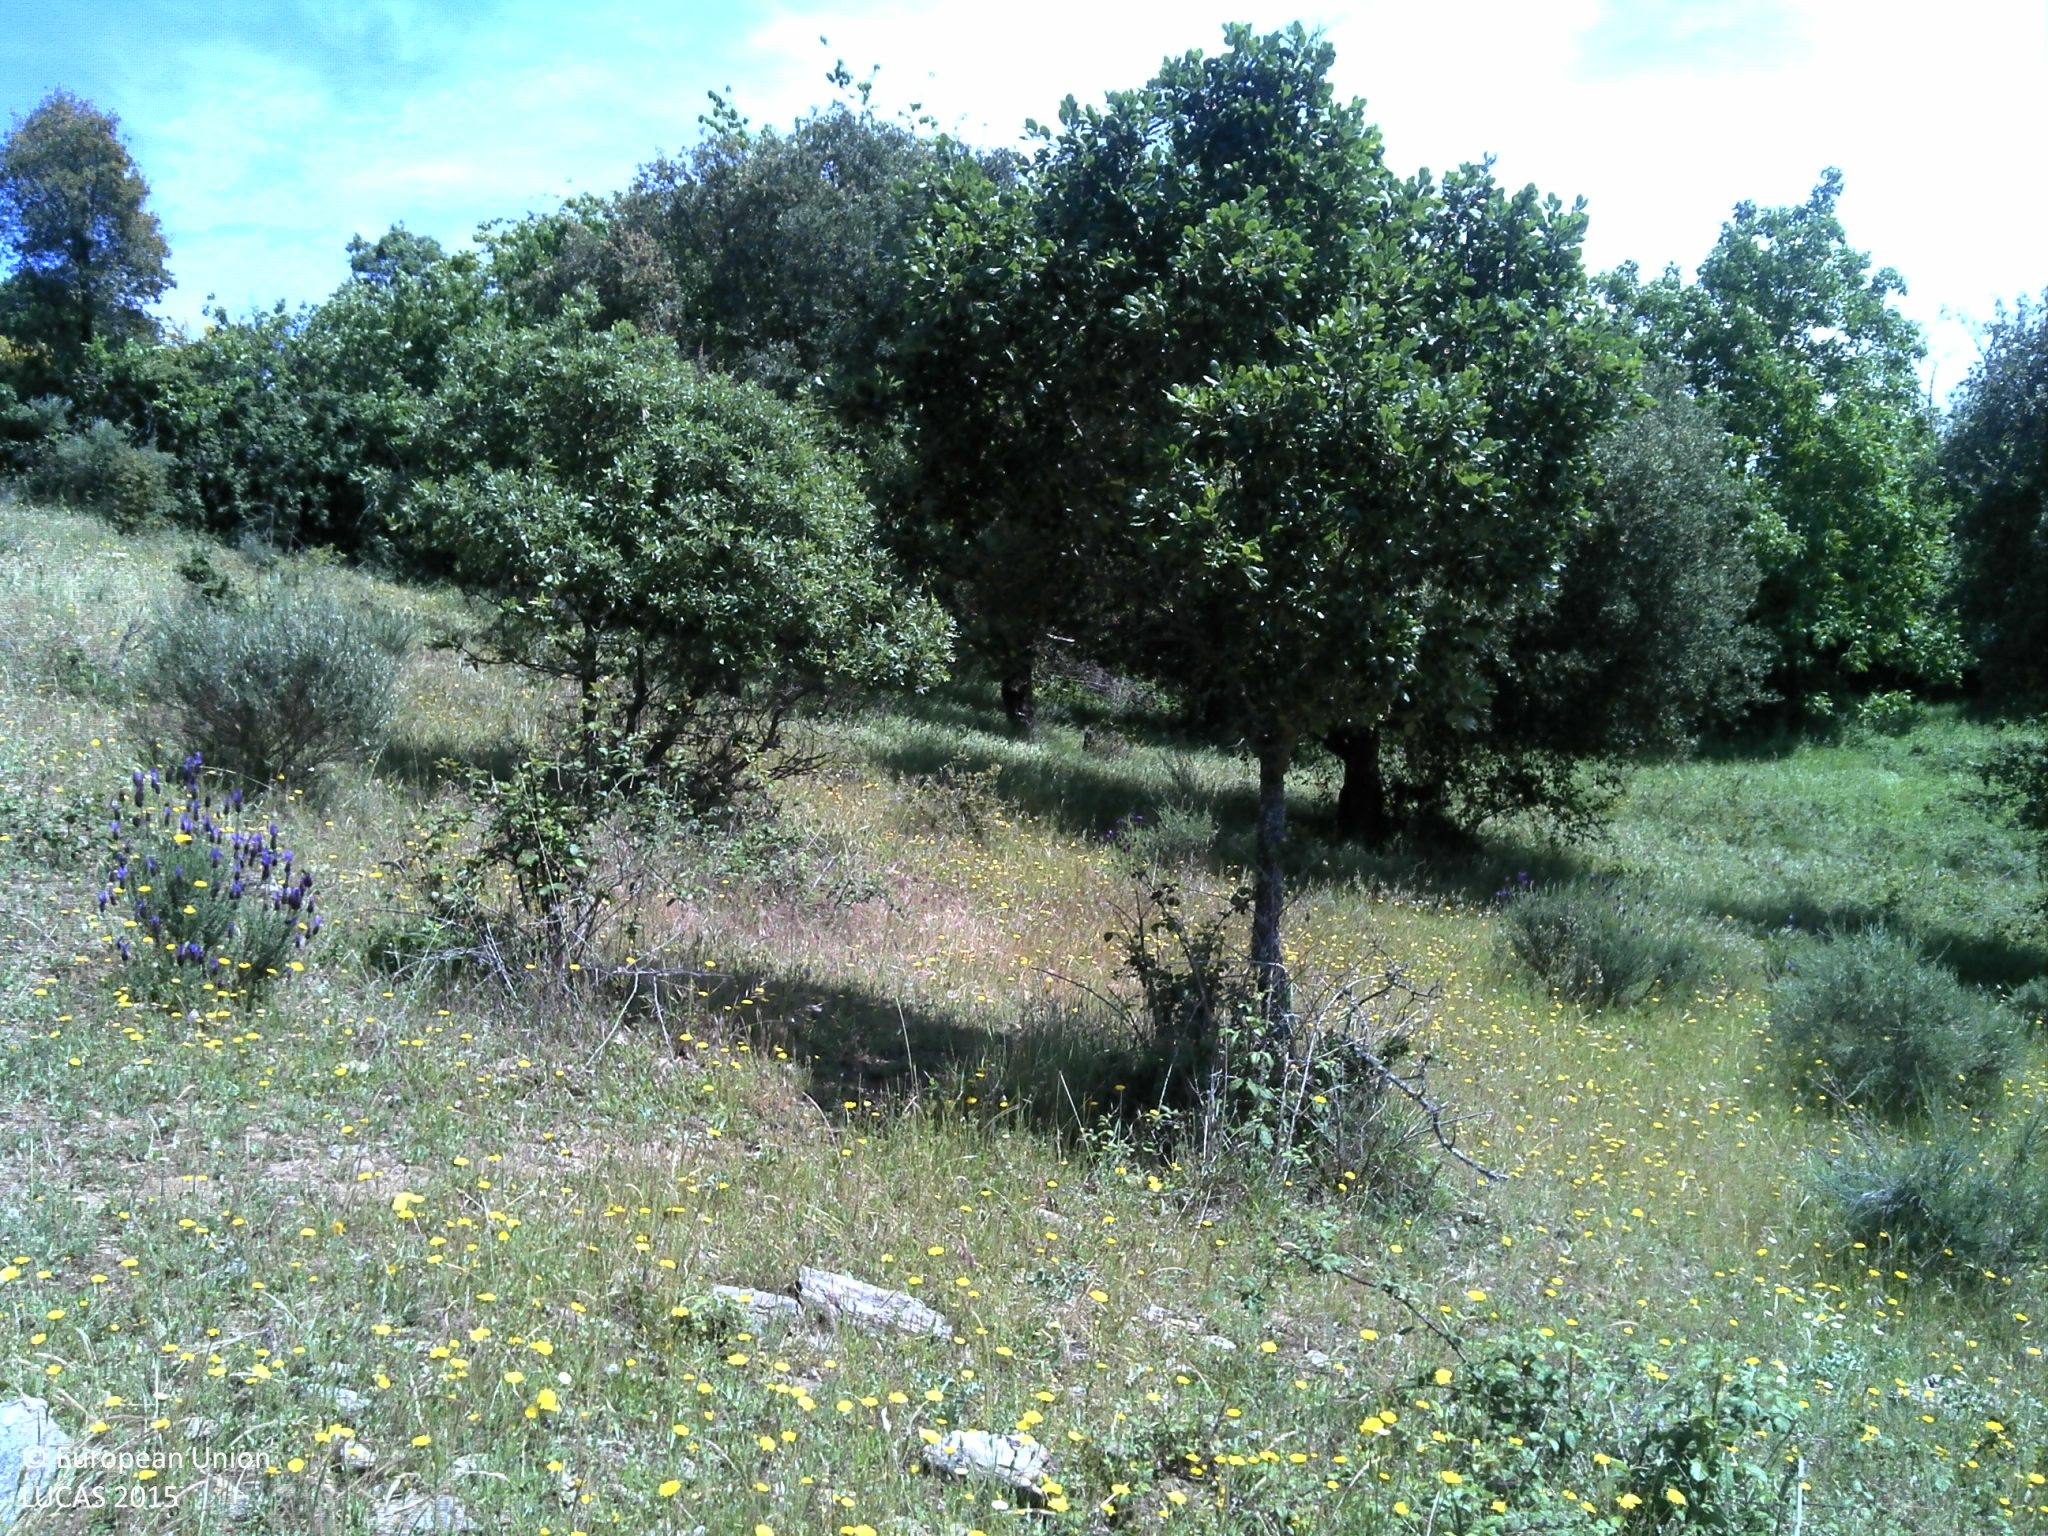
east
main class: Woodland
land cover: Broadleaved woodland
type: broadleaved evergreen forest
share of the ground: 25 - 50 %
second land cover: Spontaneously vegetated surfaces
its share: 50 - 75 %
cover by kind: herbaceous plants 50 %, broadleaved forest trees 40 %, consolidated bare surface 5 %, unconsolidated bare surface 5 %
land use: Forestry
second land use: Agriculture (excluding fallow land and kitchen gardens)
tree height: > 5 m
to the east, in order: Broadleaved woodland; Spontaneously vegetated surfaces; Broadleaved woodland; Grassland with sparse tree/shrub cover; Abandoned hedges; Shrubland with sparse tree cover; Olive groves; Grassland with sparse tree/shrub cover; Abandoned hedges; Dry stone walls; Spontaneously vegetated surfaces; Shrubland without tree cover; Broadleaved woodland
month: May
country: PT
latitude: 41.5881
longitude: -7.0183
